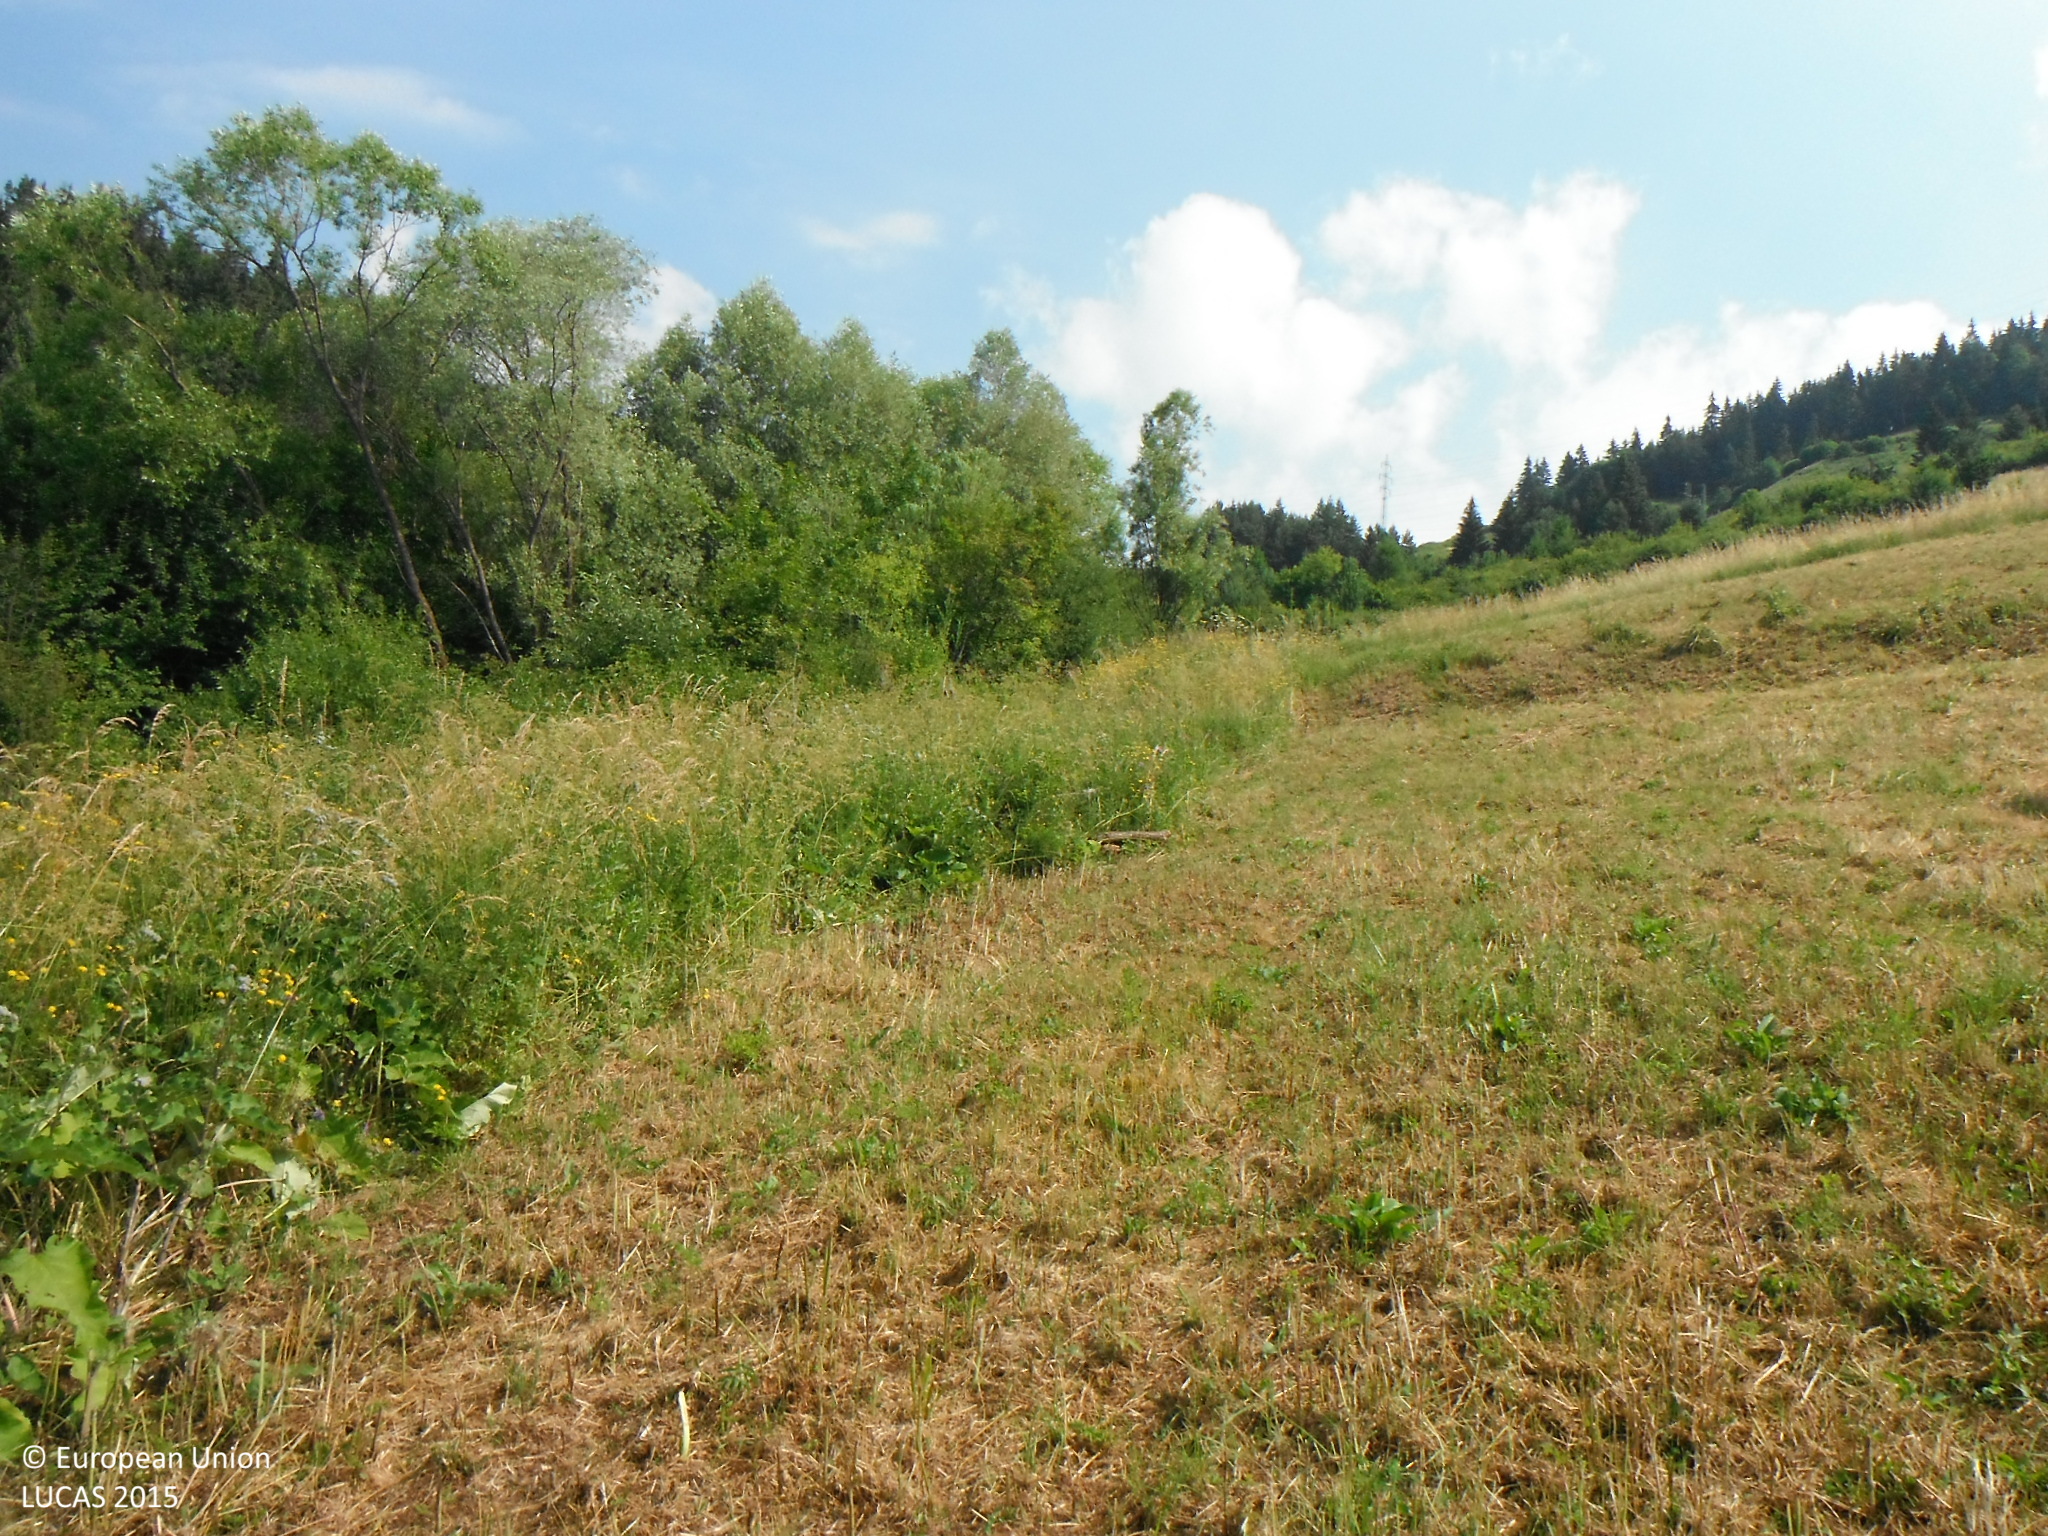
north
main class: Grassland
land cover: Grassland without tree/shrub cover
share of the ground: > 75 %
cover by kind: herbaceous plants 100 %
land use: Agriculture (excluding fallow land and kitchen gardens)
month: July
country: SK
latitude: 49.1017
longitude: 19.4629
